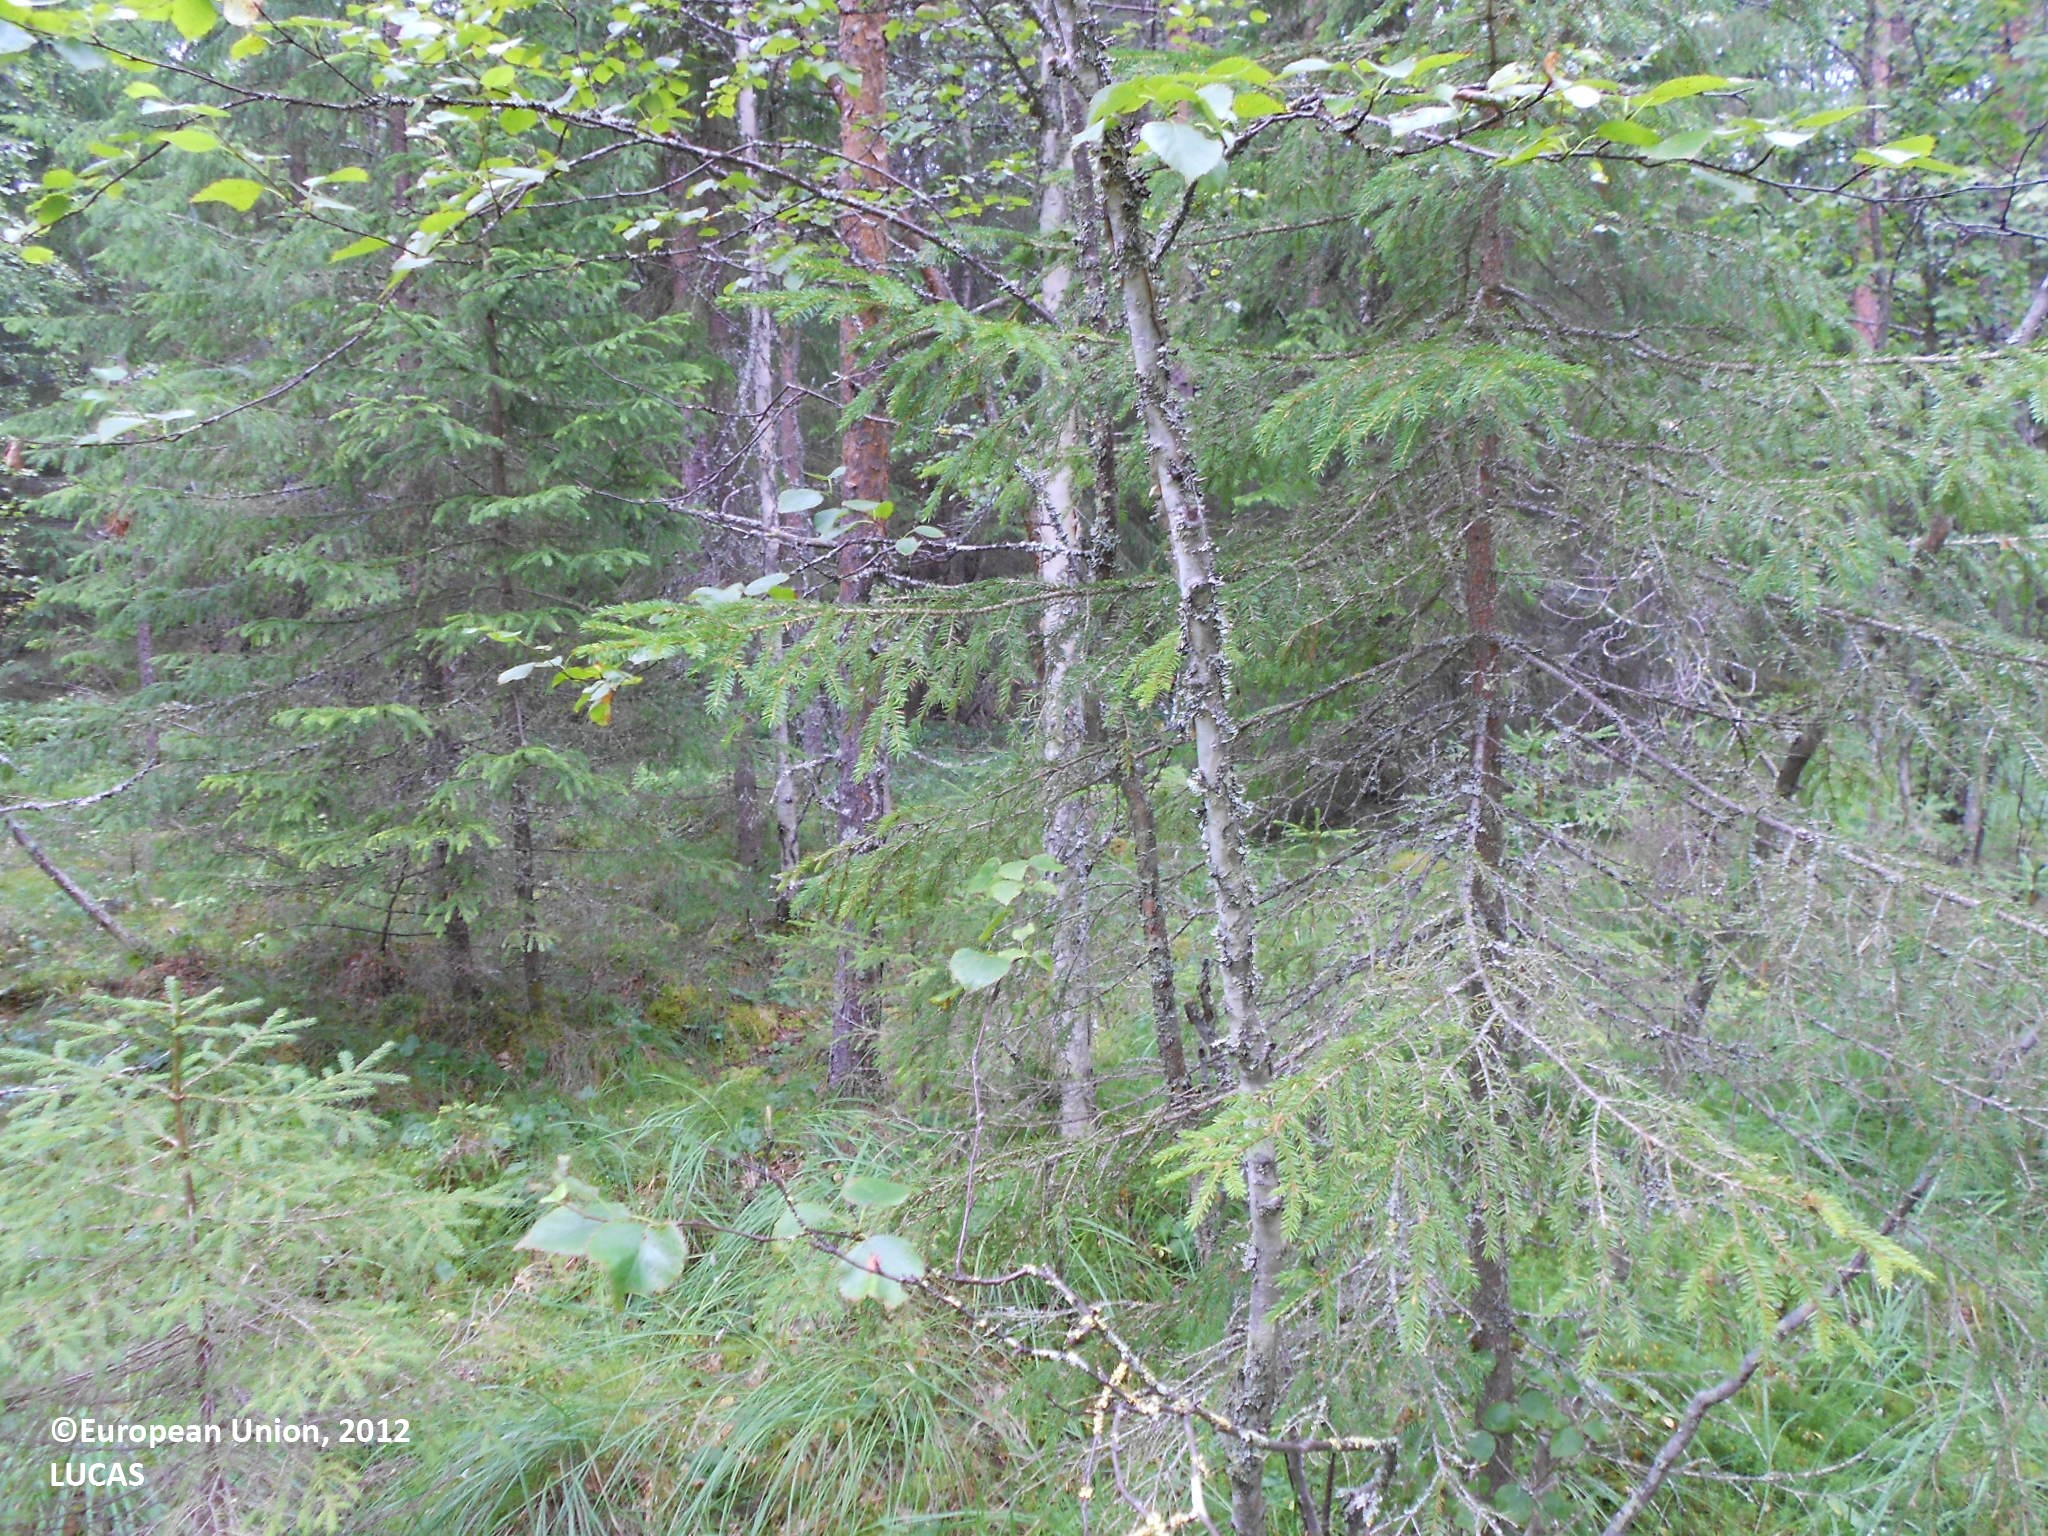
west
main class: Woodland
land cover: Pine dominated coniferous woodland
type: boreal forest
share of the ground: 50 - 75 %
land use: Forestry
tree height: > 5 m
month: August
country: FI
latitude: 63.4263
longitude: 28.9402
